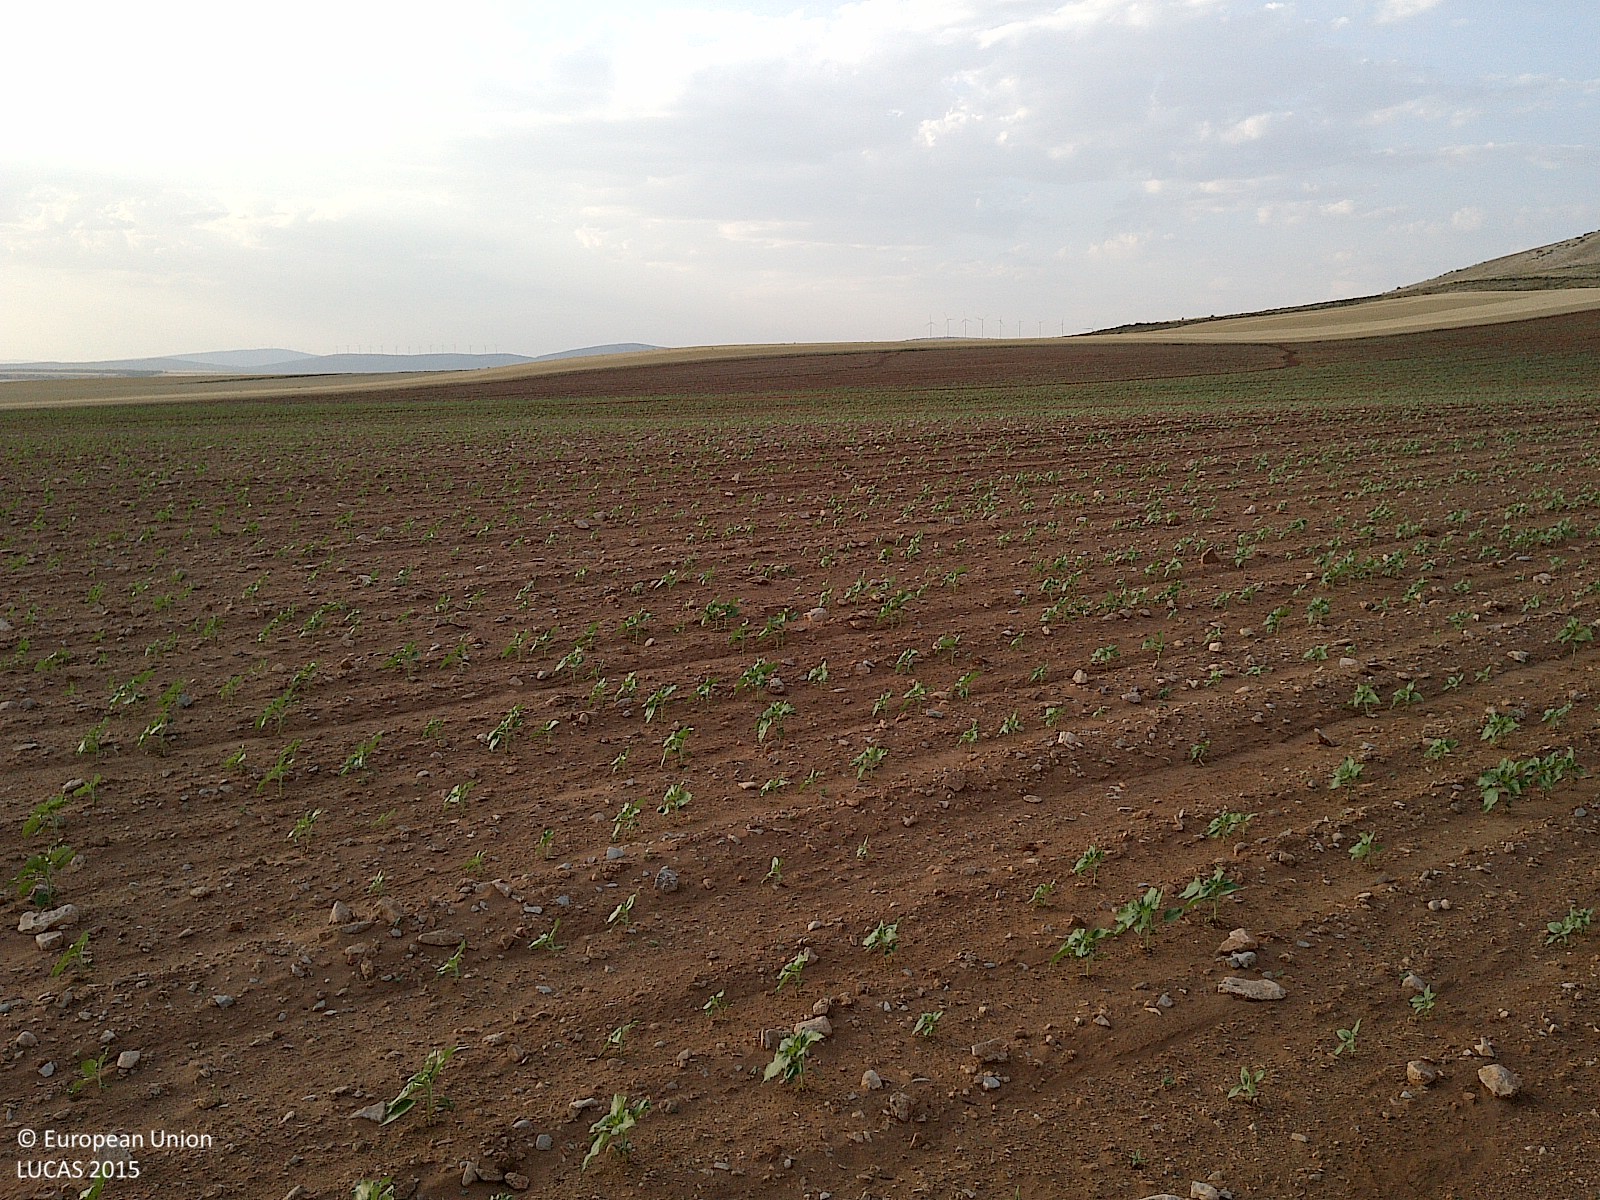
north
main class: Cropland
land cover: Sunflower
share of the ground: < 10 %
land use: Agriculture (excluding fallow land and kitchen gardens)
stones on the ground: < 10 %
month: June
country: ES
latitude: 41.6463
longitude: -2.1478
